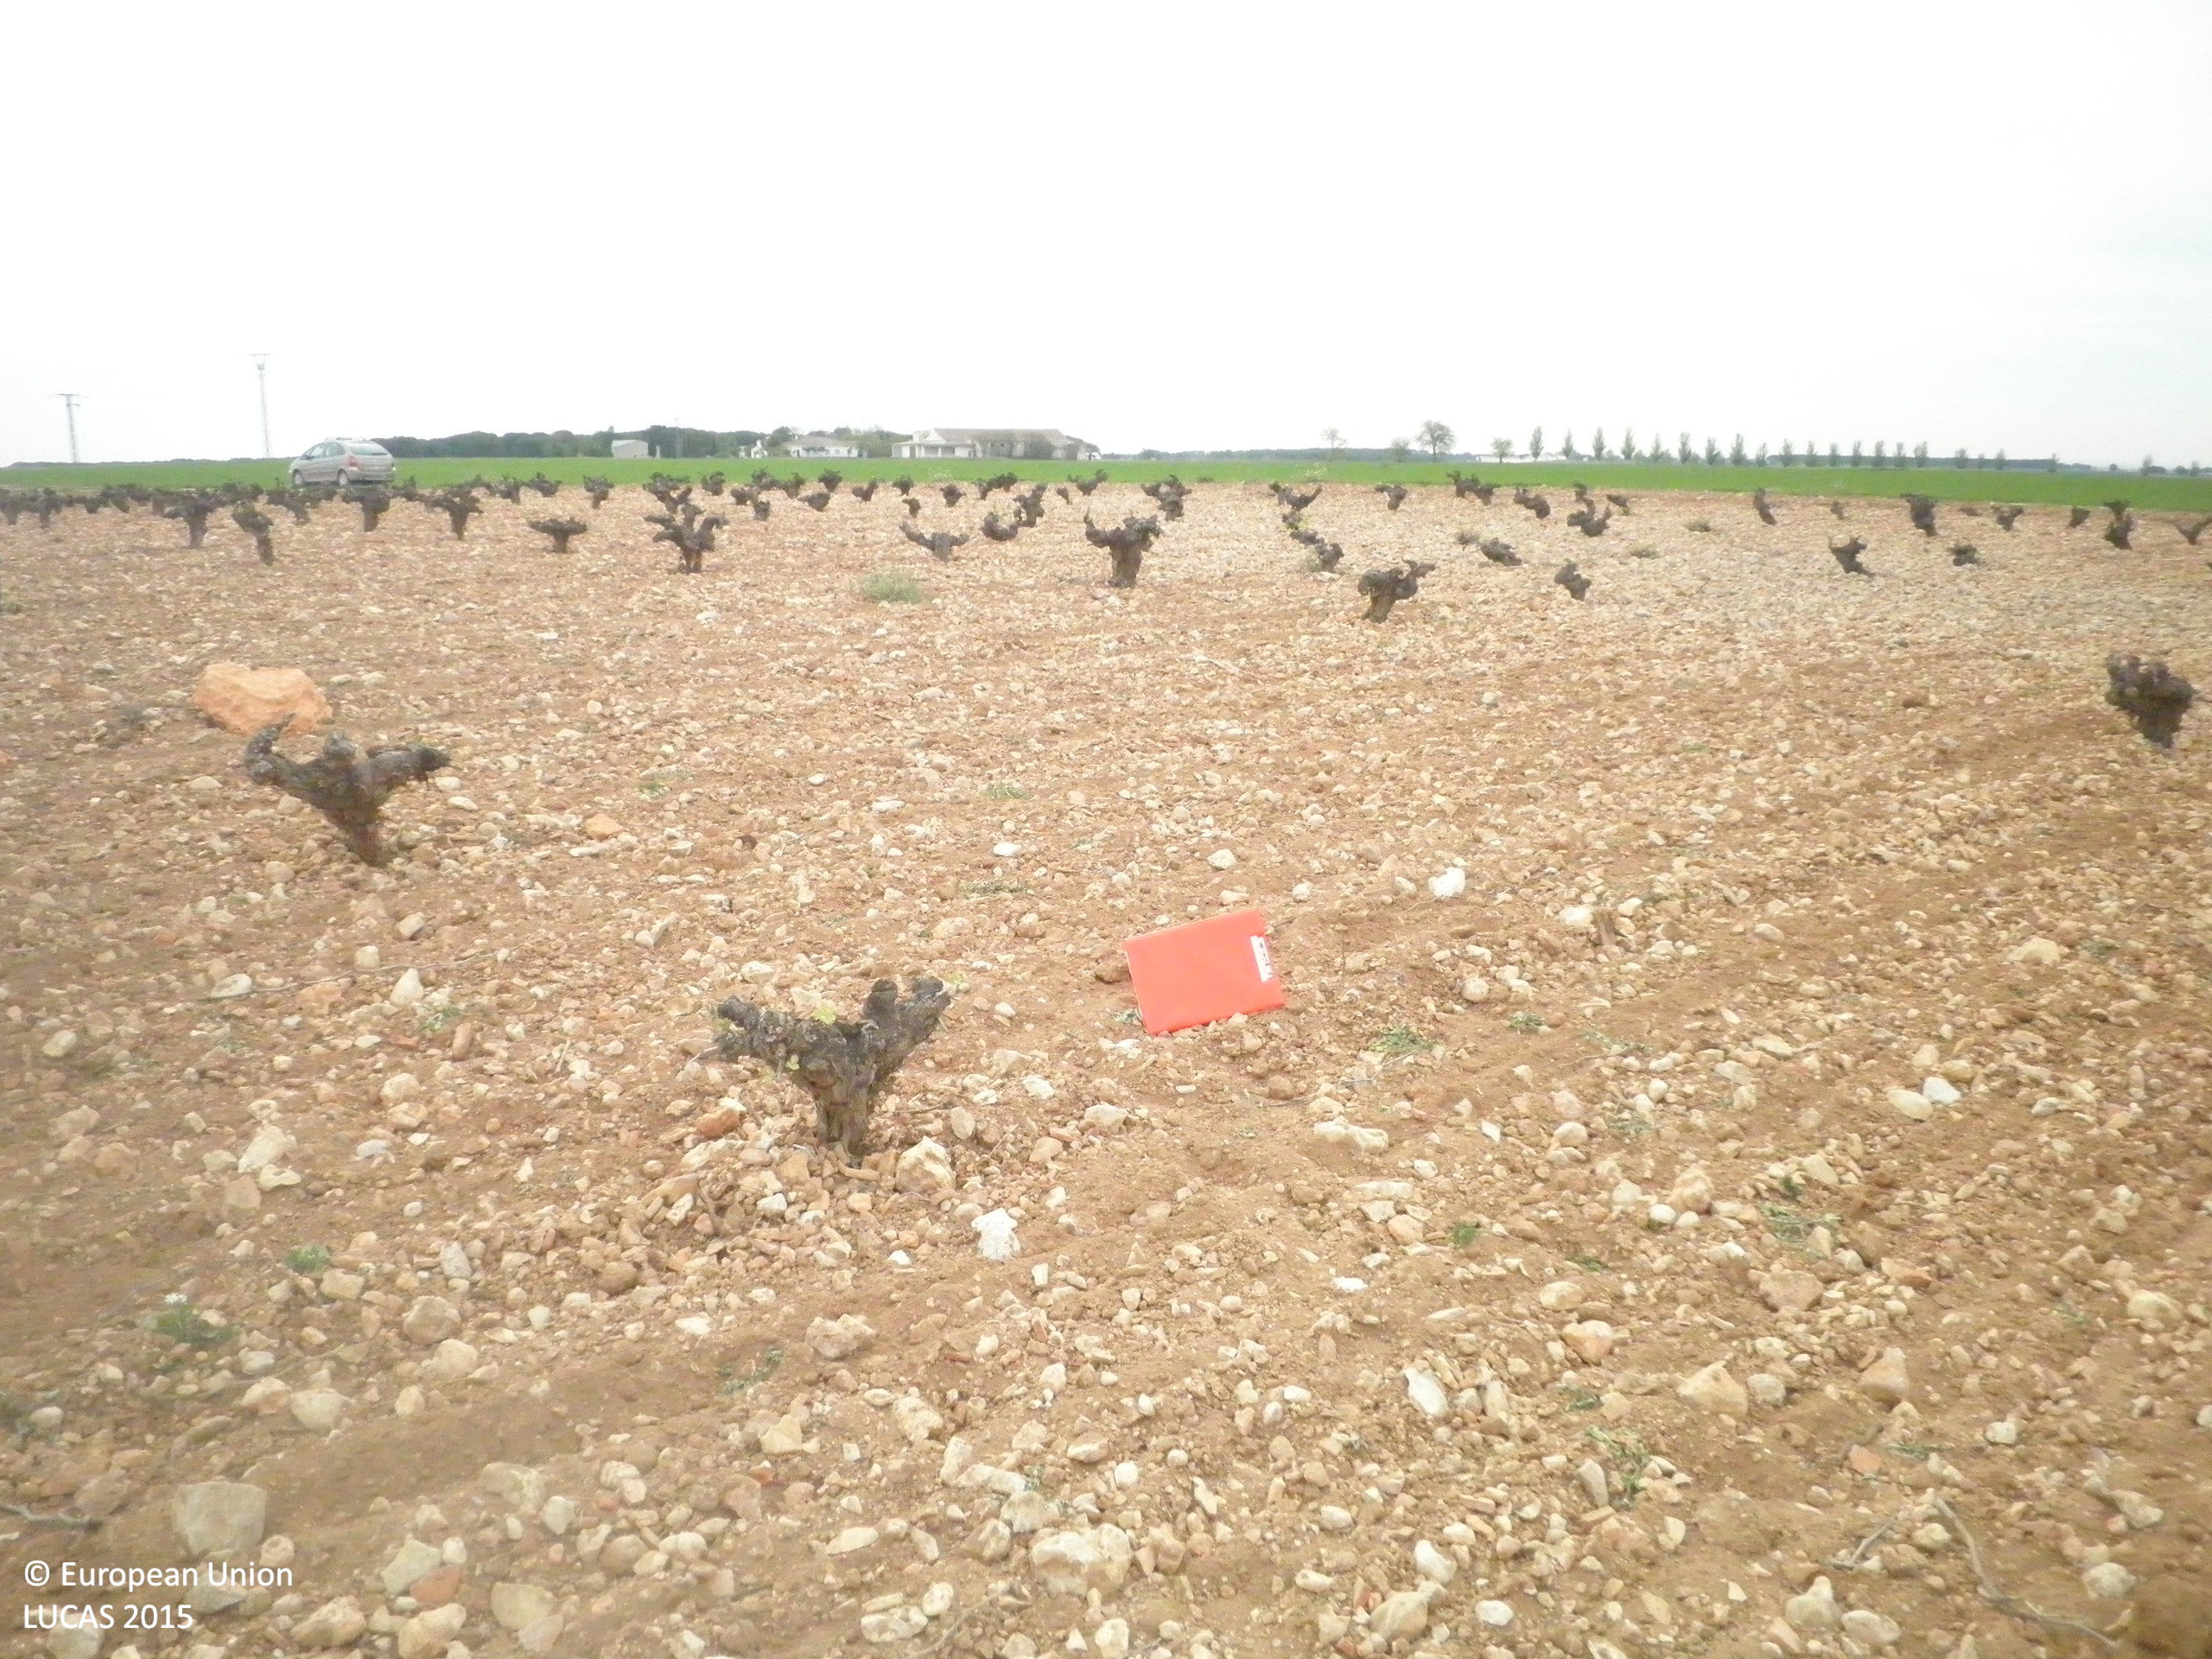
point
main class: Cropland
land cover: Vineyards
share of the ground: < 10 %
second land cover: Other bare soil
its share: > 75 %
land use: Agriculture (excluding fallow land and kitchen gardens)
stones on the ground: > 50 %
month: April
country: ES
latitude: 39.4011
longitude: -2.7053
